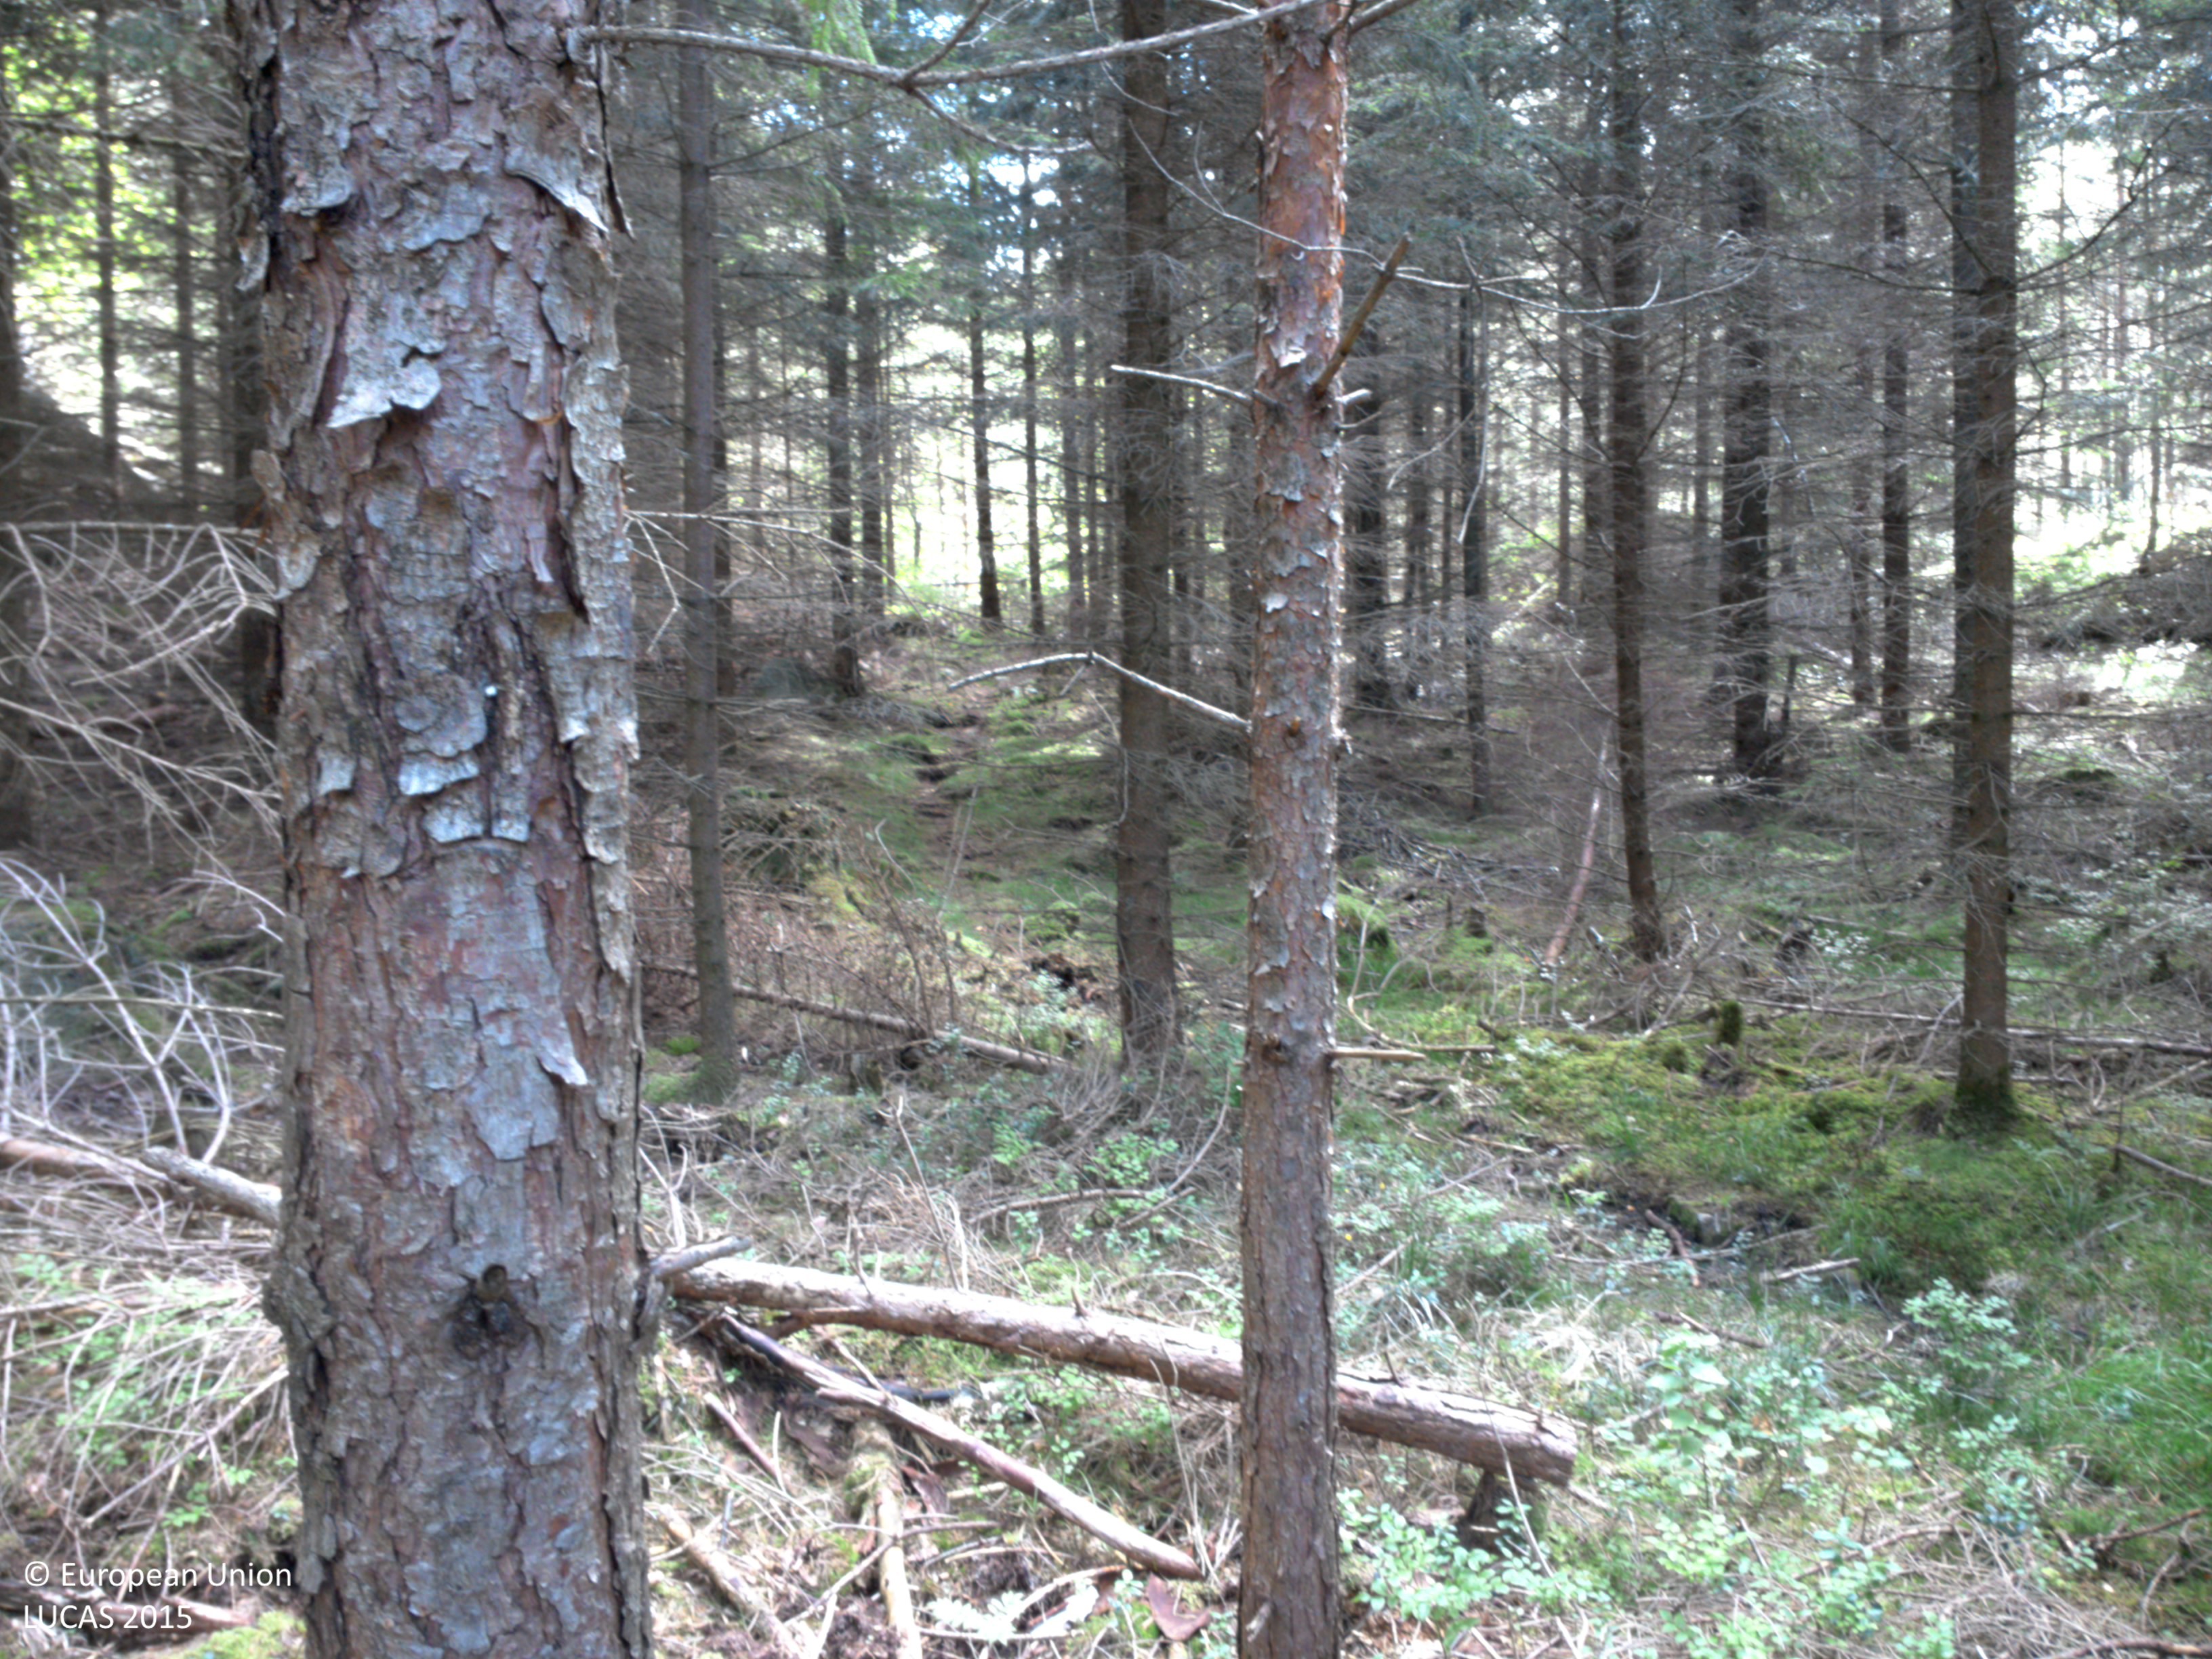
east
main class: Woodland
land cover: Other coniferous woodland
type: boreal forest
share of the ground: > 75 %
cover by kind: coniferous forest trees 90 %, shrubs 5 %, lichens and mosses 5 %
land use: Forestry
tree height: > 5 m
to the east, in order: Other coniferous woodland; Spruce dominated coniferous woodland; Spruce dominated mixed woodland; Pine dominated mixed woodland; Spruce dominated coniferous woodland; Spruce dominated mixed woodland
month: August
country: SE
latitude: 58.0076
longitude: 11.9426
